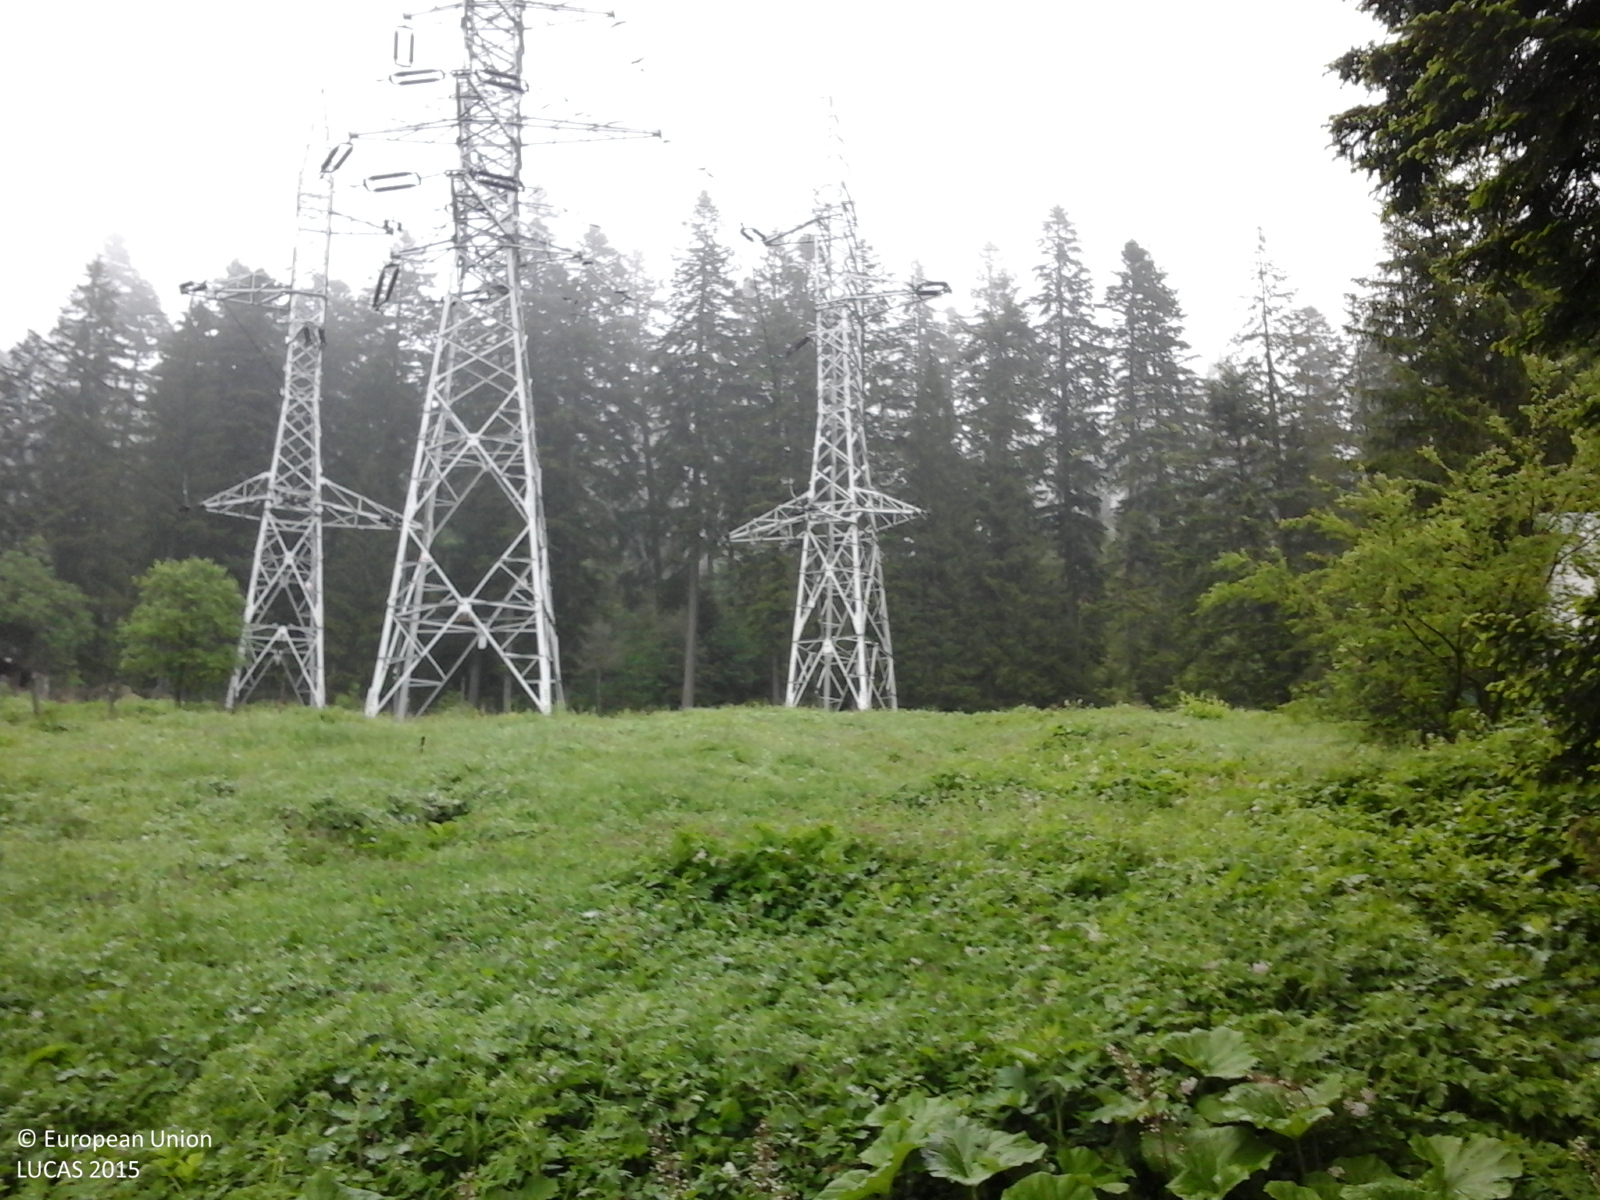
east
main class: Woodland
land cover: Spruce dominated coniferous woodland
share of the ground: > 75 %
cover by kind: coniferous forest trees 80 %, herbaceous plants 20 %
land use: Forestry
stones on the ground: < 10 %
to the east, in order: Spruce dominated coniferous woodland; Grassland without tree/shrub cover; Electric lines; Grassland without tree/shrub cover; Tracks; Grass margins; Tracks; Grass margins; Ditches and canals; Spruce dominated mixed woodland; Tracks; Spruce dominated mixed woodland
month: May
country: RO
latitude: 45.4950
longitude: 25.5735
